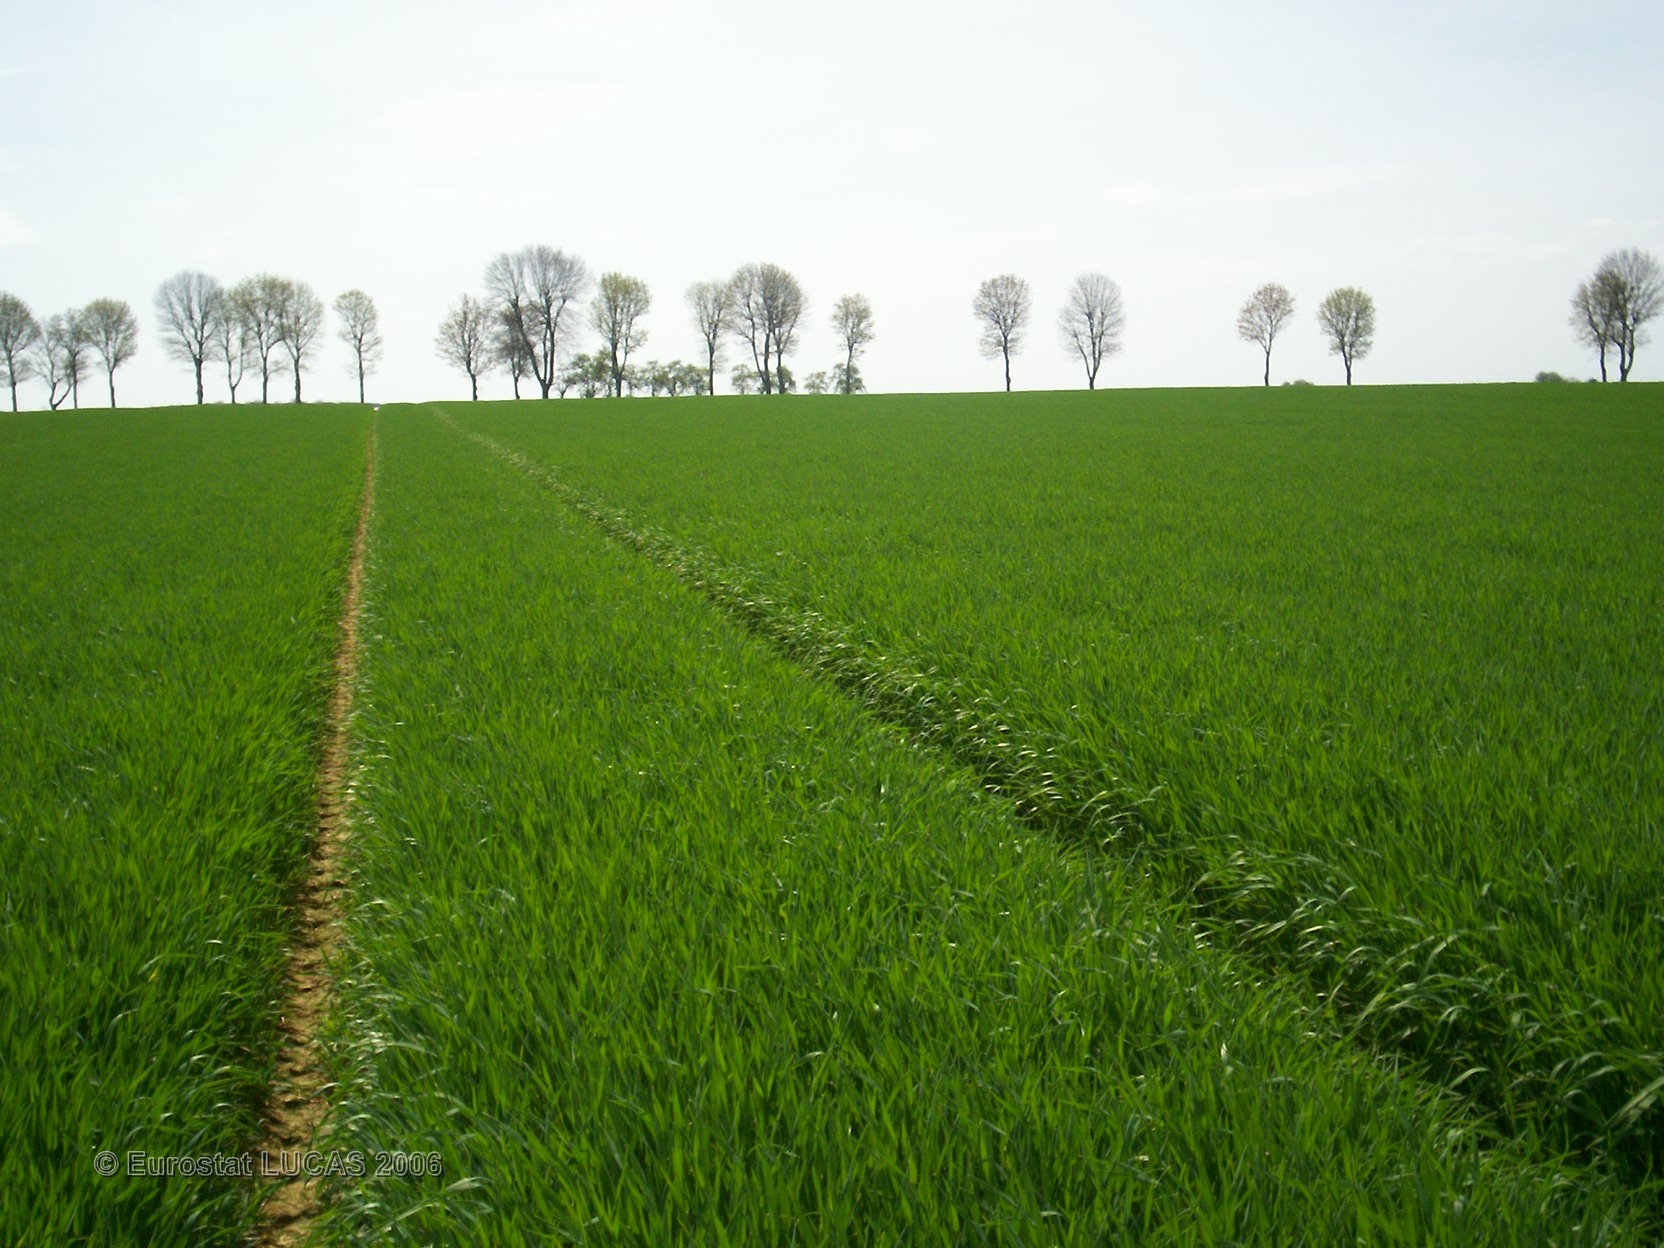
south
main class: Cropland
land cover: Barley
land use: Agriculture (excluding fallow land and kitchen gardens)
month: May
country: FR
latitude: 47.8574
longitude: 4.6121
